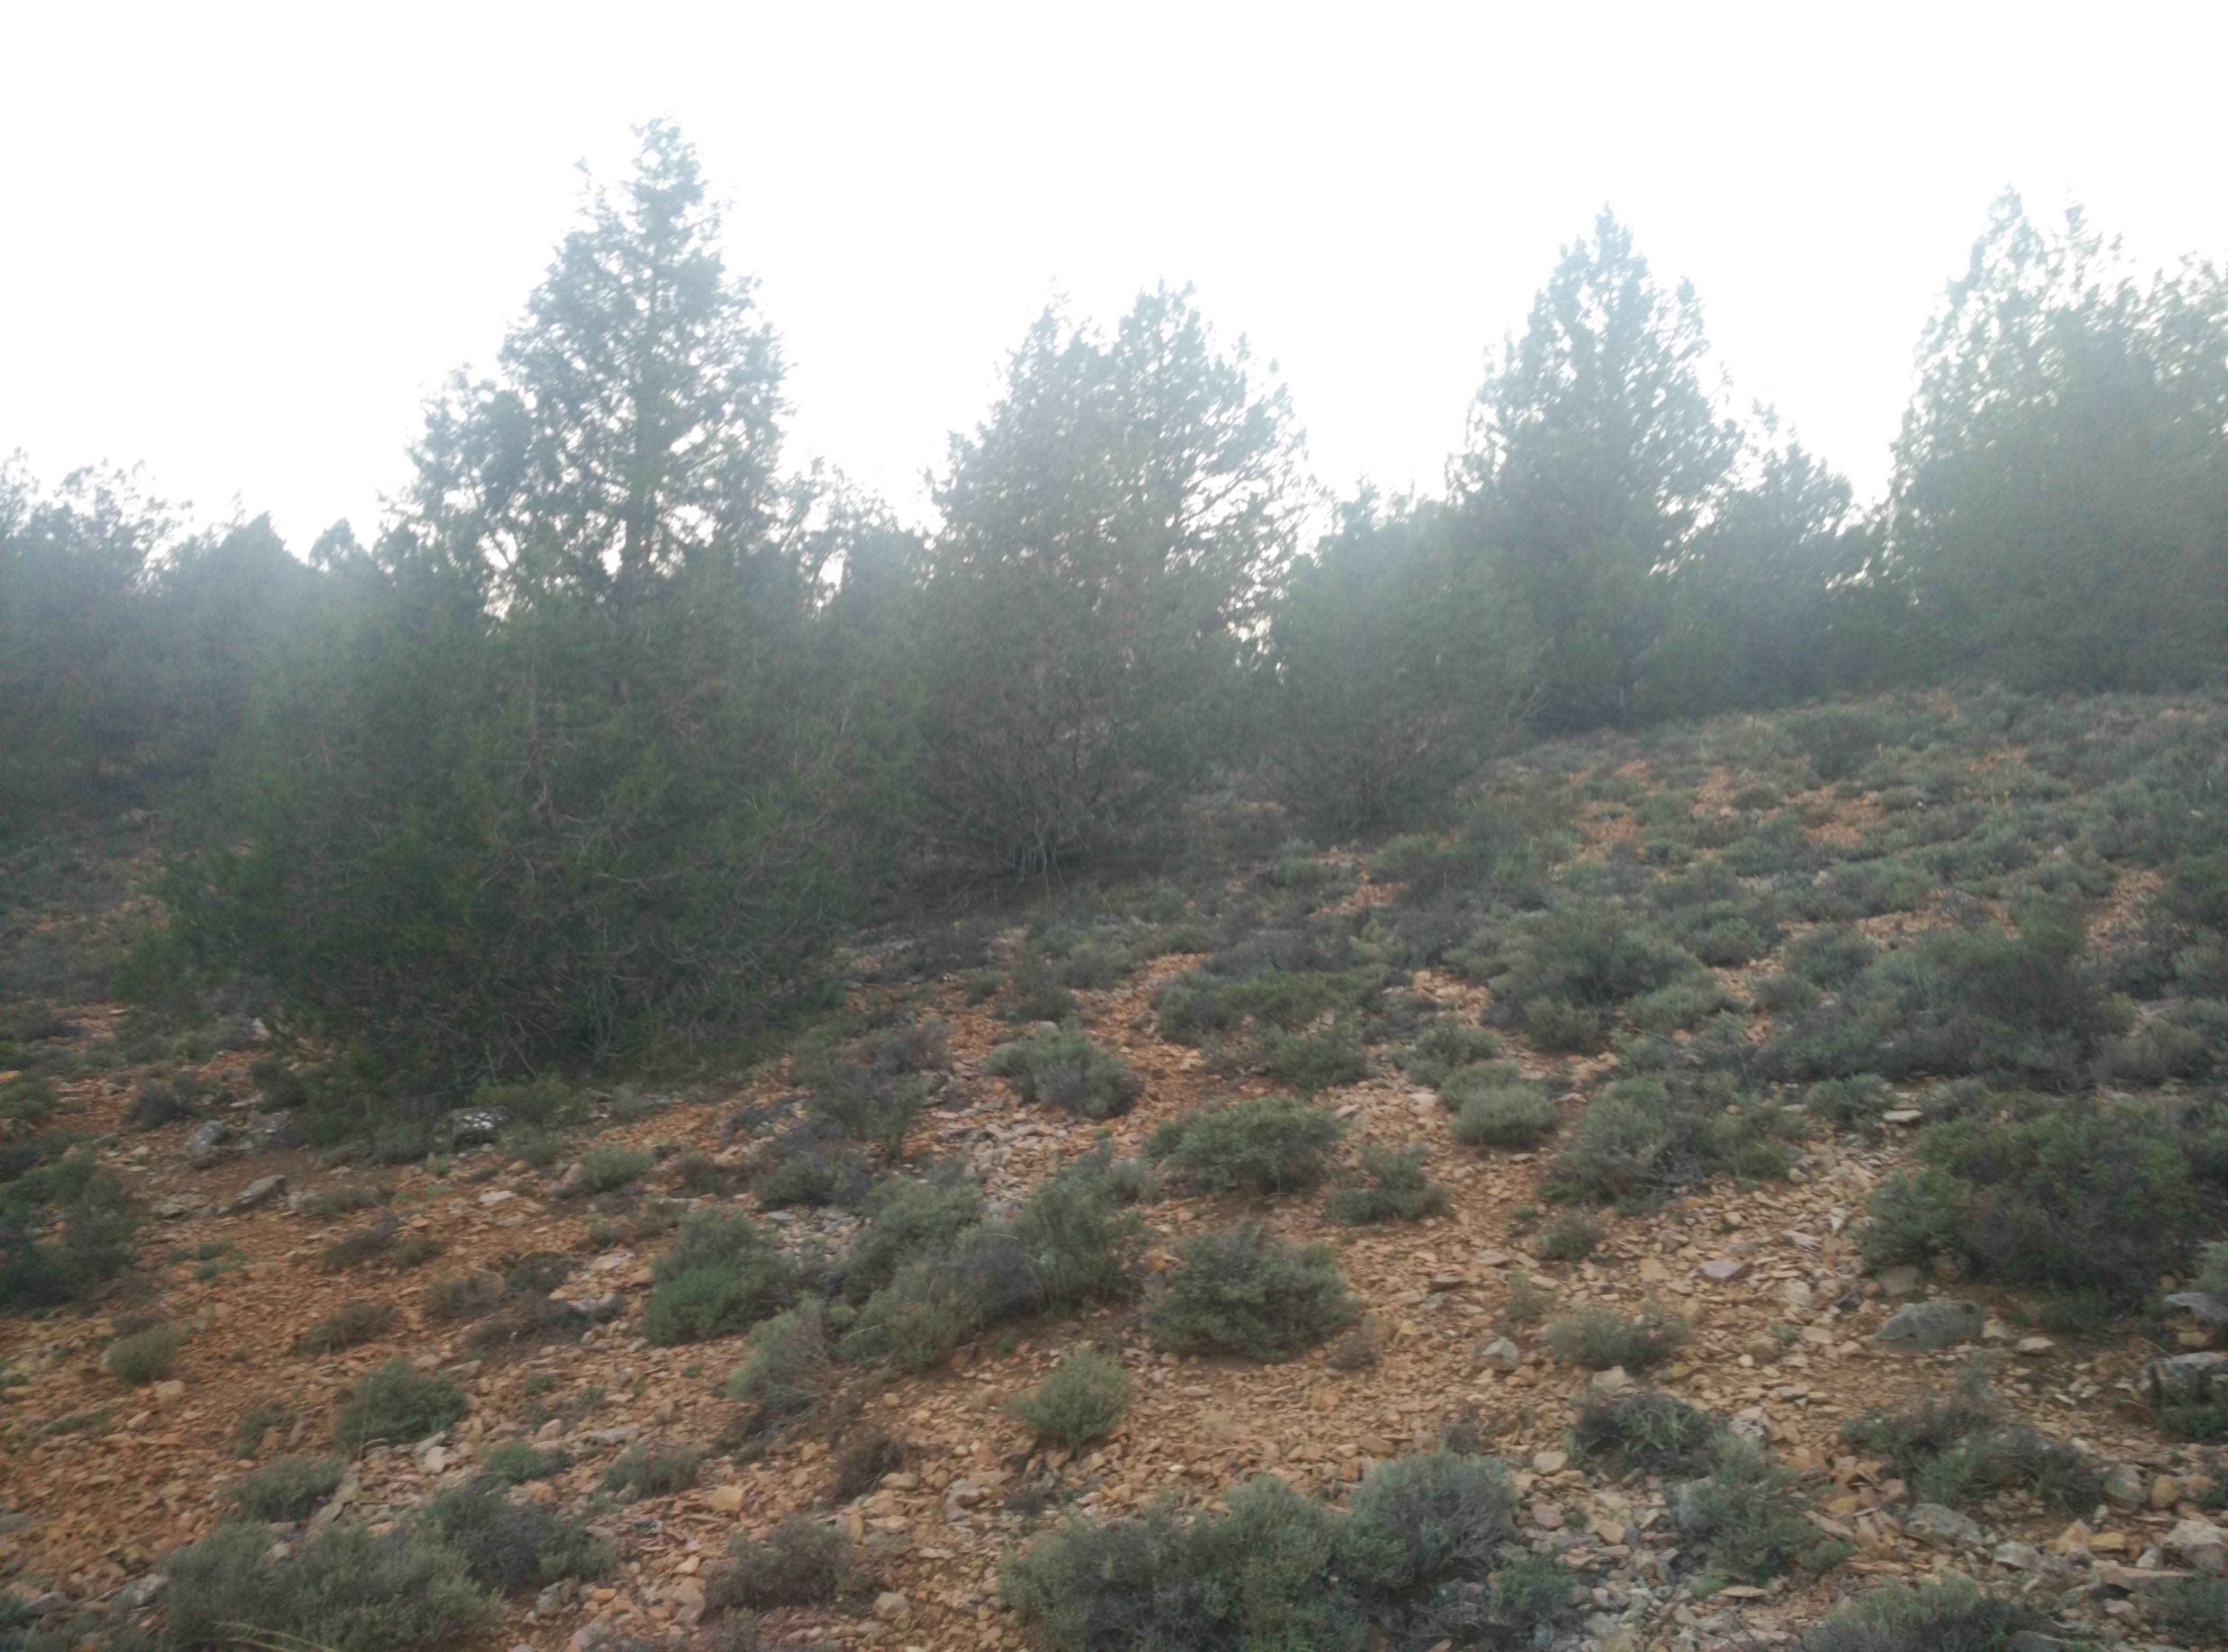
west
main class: Woodland
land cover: Other coniferous woodland
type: coniferous forest of the mediterranean region
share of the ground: 25 - 50 %
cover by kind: unconsolidated bare surface 60 %, coniferous forest trees 30 %, shrubs 10 %
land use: Semi-natural and natural areas not in use
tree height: > 5 m
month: June
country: ES
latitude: 40.7700
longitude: -2.0002
